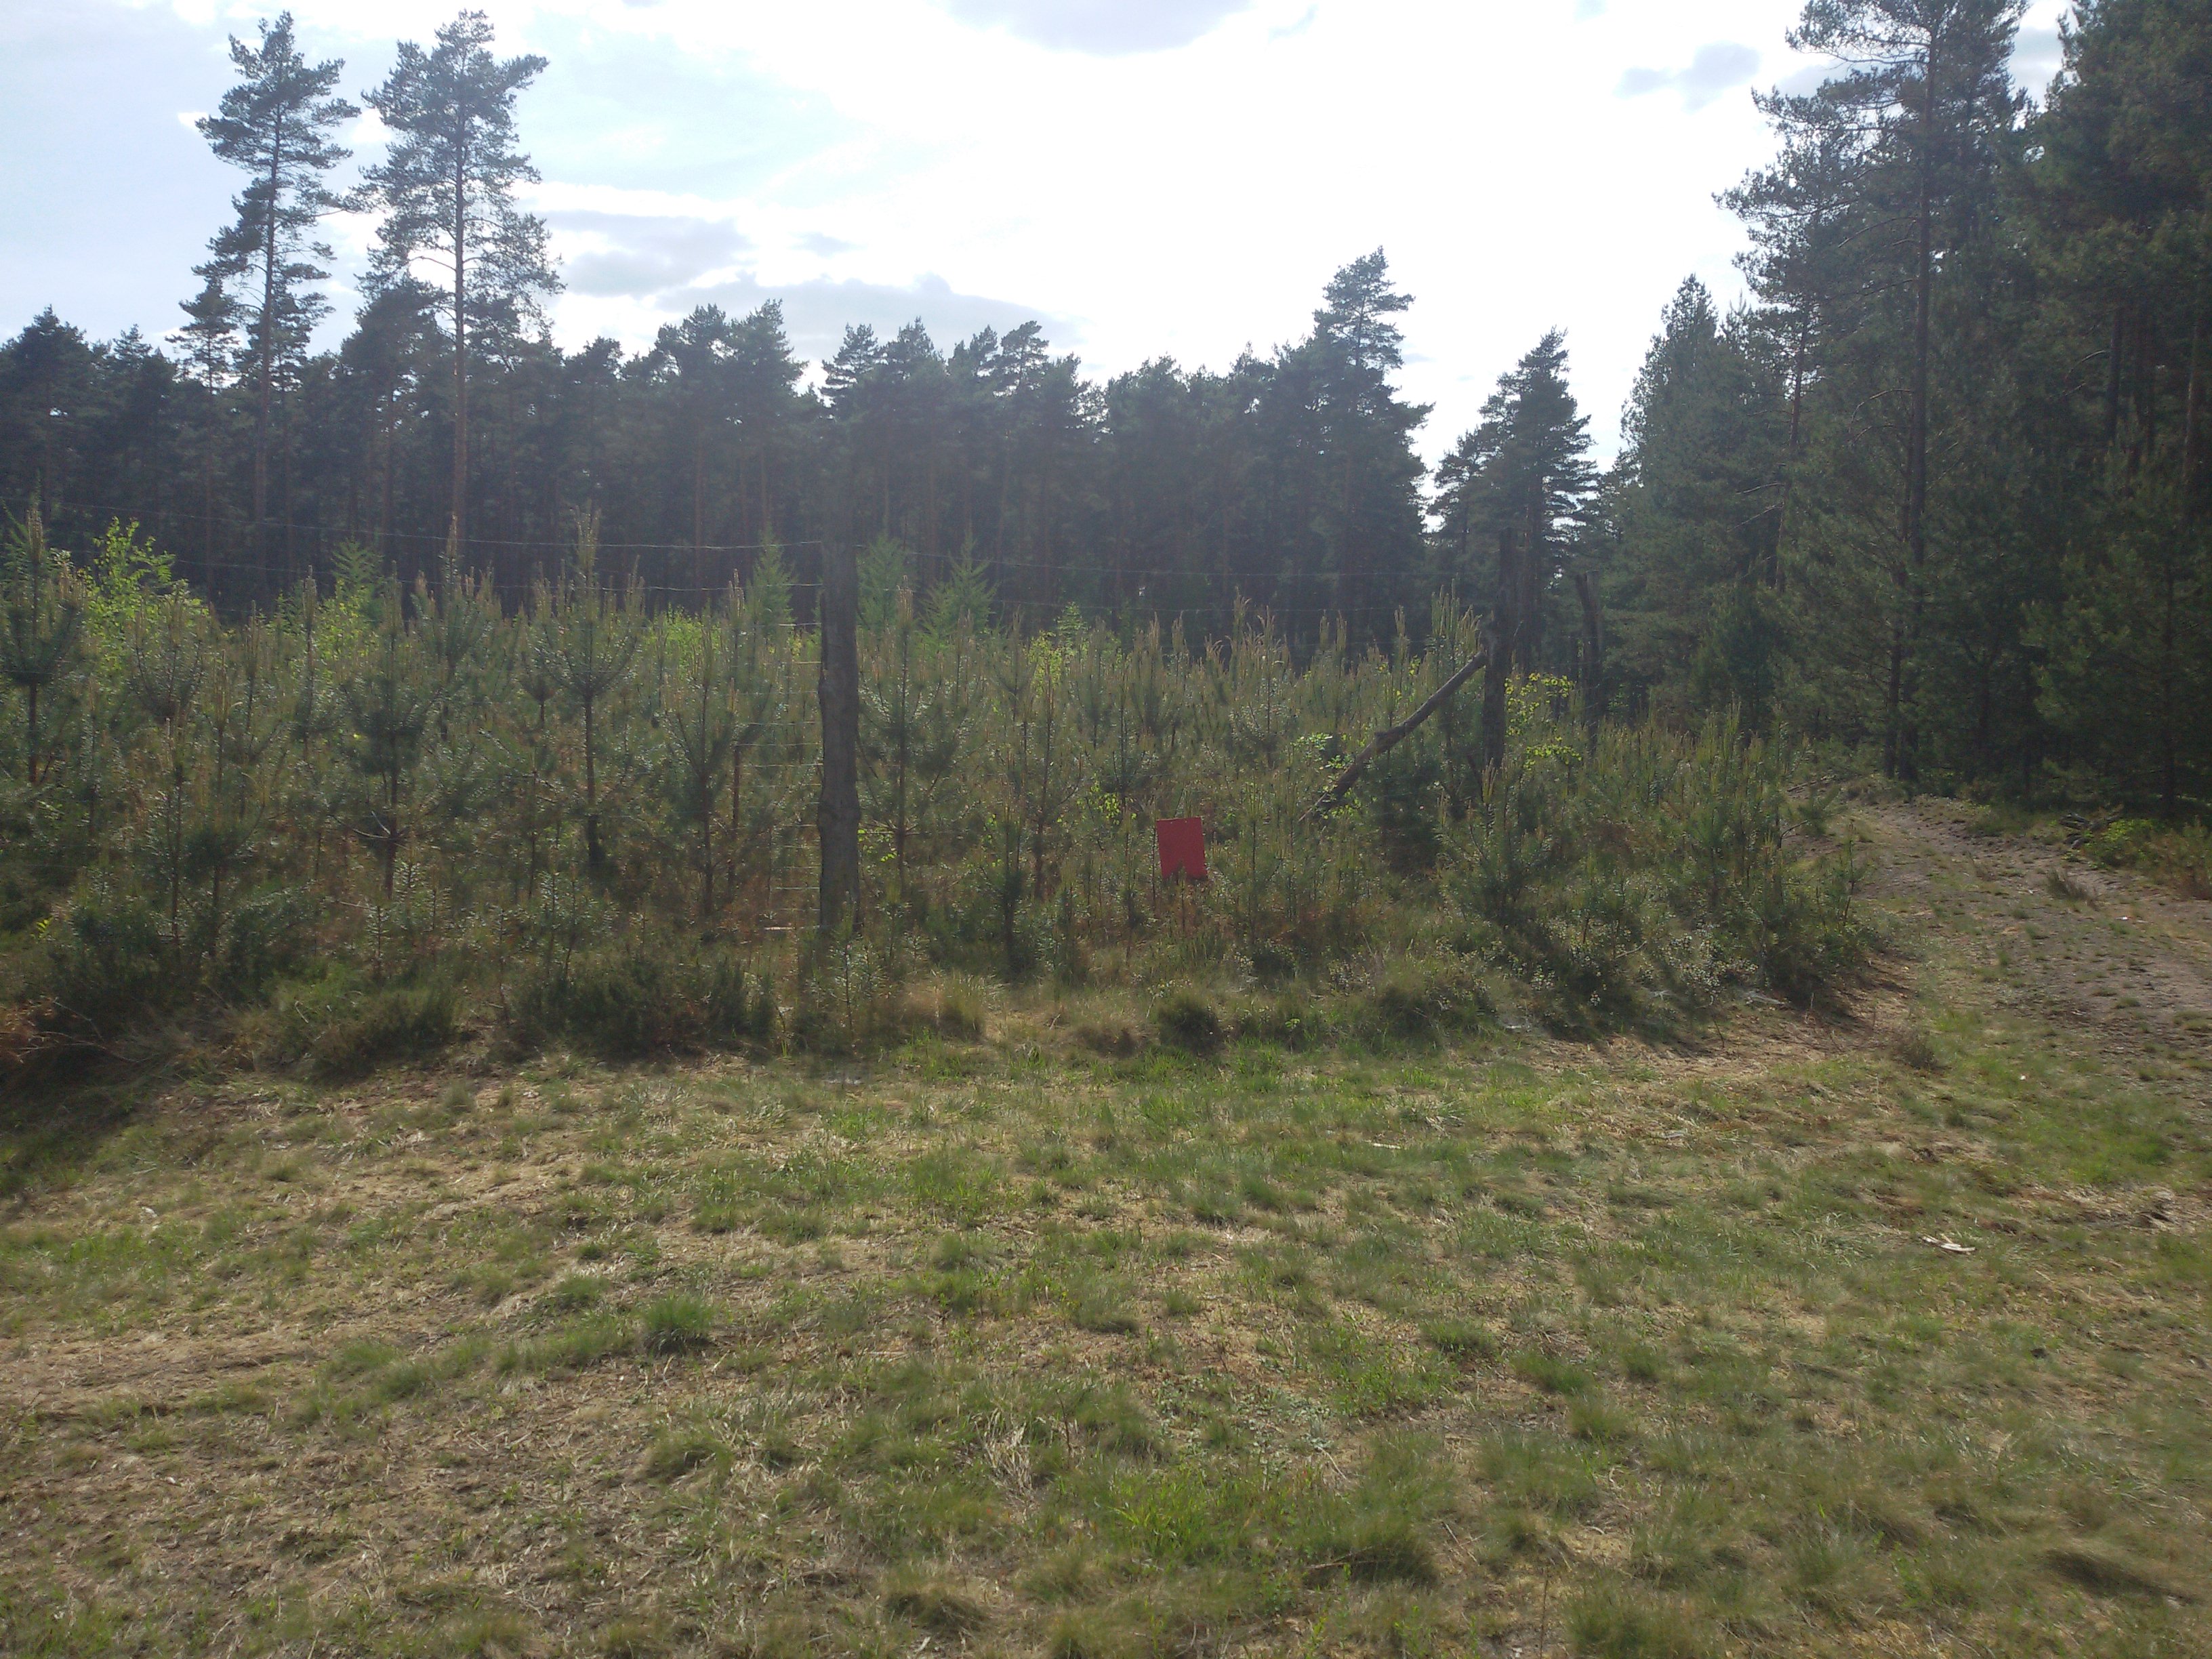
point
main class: Woodland
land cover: Pine dominated coniferous woodland
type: hemiboreal forest and nemoral coniferous forest and mixed broadleaved-coniferous forest
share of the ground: > 75 %
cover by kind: coniferous forest trees 75 %, herbaceous plants 15 %, broadleaved forest trees 5 %, lichens and mosses 5 %
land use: Forestry
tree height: < 5 m
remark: Nursery
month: May
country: PL
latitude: 51.3131
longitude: 15.4990
